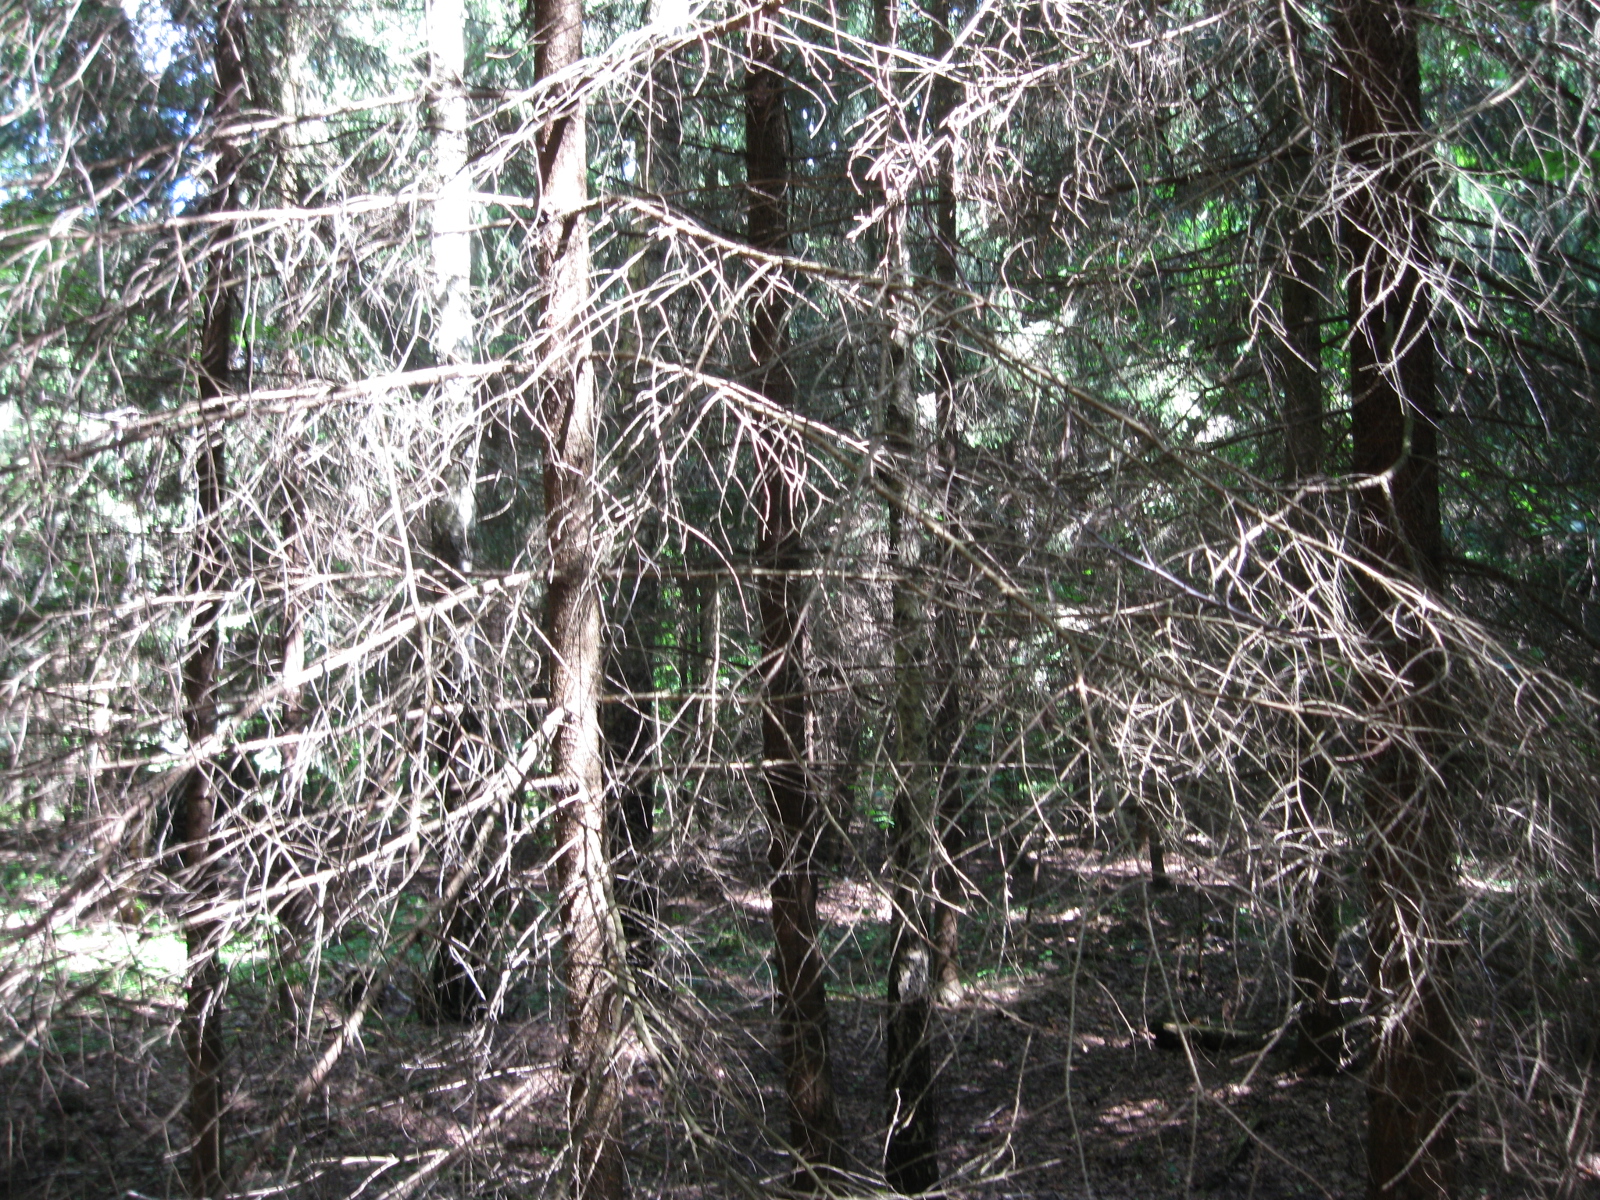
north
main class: Woodland
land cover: Spruce dominated mixed woodland
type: hemiboreal forest and nemoral coniferous forest and mixed broadleaved-coniferous forest
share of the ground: > 75 %
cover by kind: coniferous forest trees 70 %, broadleaved forest trees 30 %
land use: Forestry
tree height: > 5 m
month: June
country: LT
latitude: 55.1326
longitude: 23.7466
